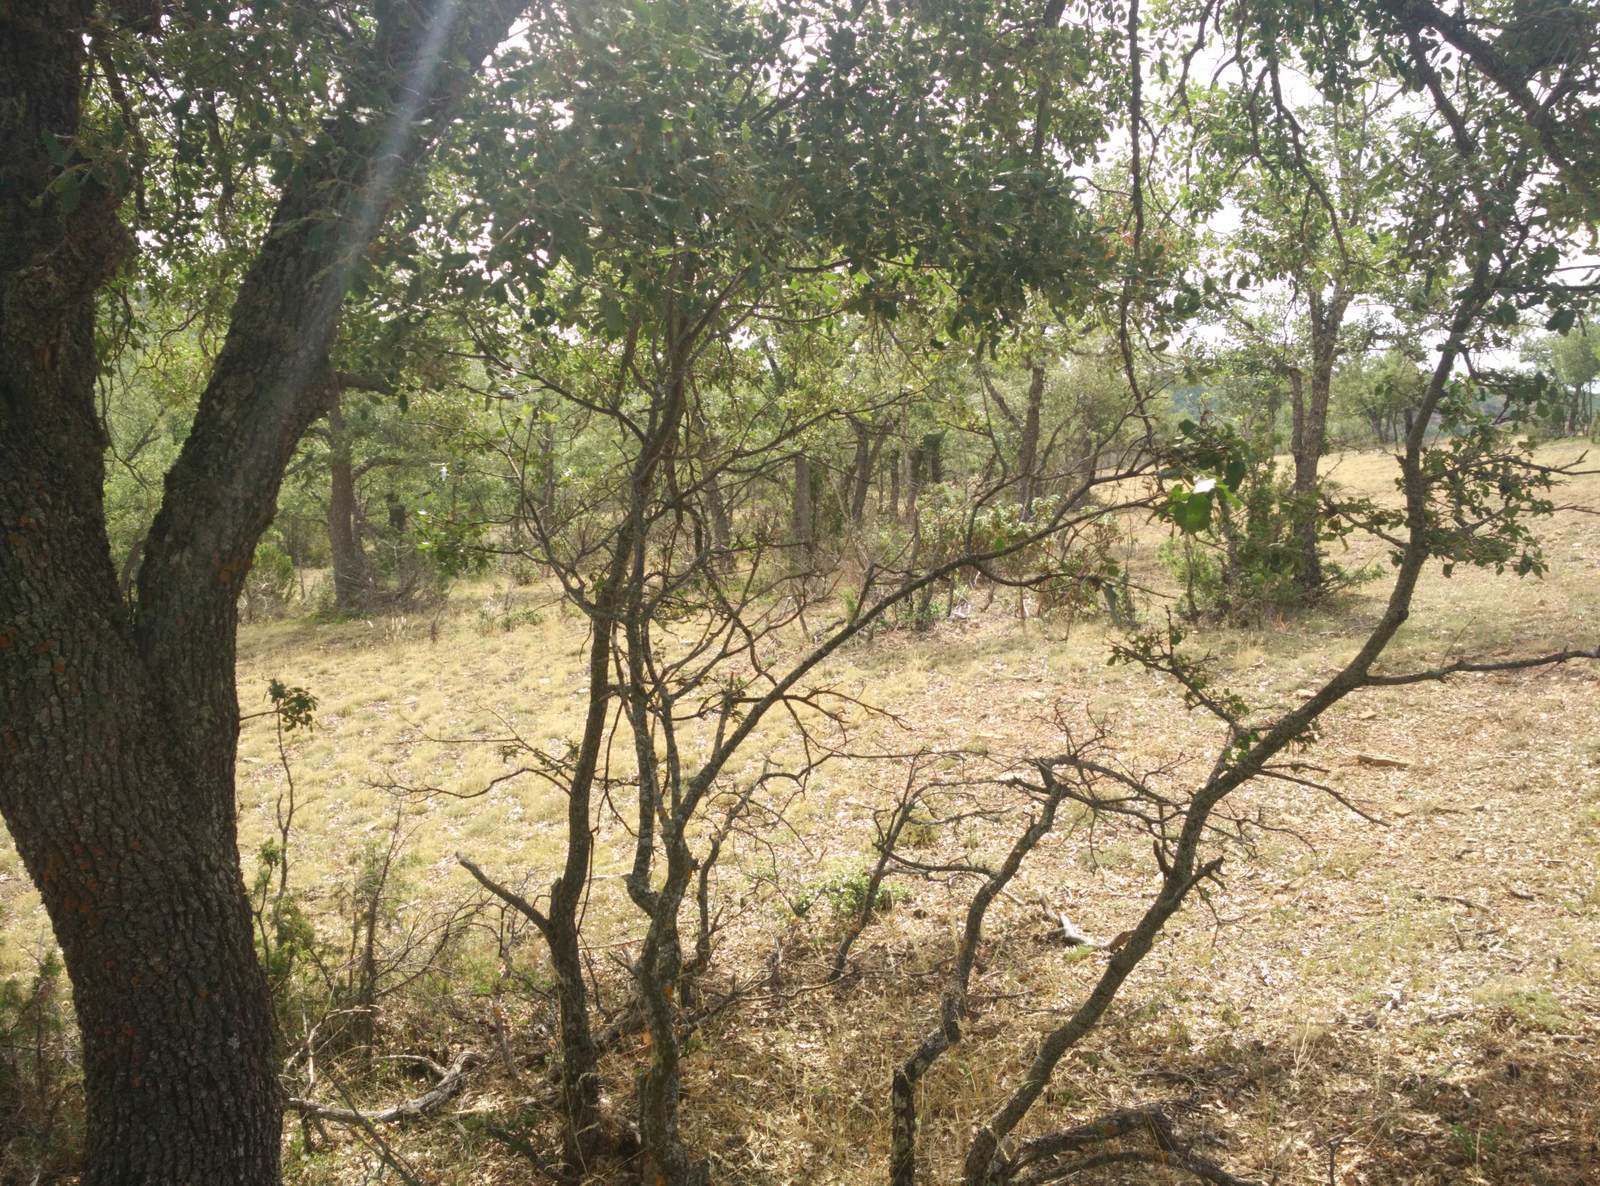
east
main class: Grassland
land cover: Grassland with sparse tree/shrub cover
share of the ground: 50 - 75 %
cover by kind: herbaceous plants 60 %, unconsolidated bare surface 30 %, broadleaved forest trees 5 %, shrubs 5 %
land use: Semi-natural and natural areas not in use
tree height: > 5 m
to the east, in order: Grassland with sparse tree/shrub cover; Broadleaved woodland; Grassland without tree/shrub cover; Broadleaved woodland
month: July
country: ES
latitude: 40.9362
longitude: -1.9843
